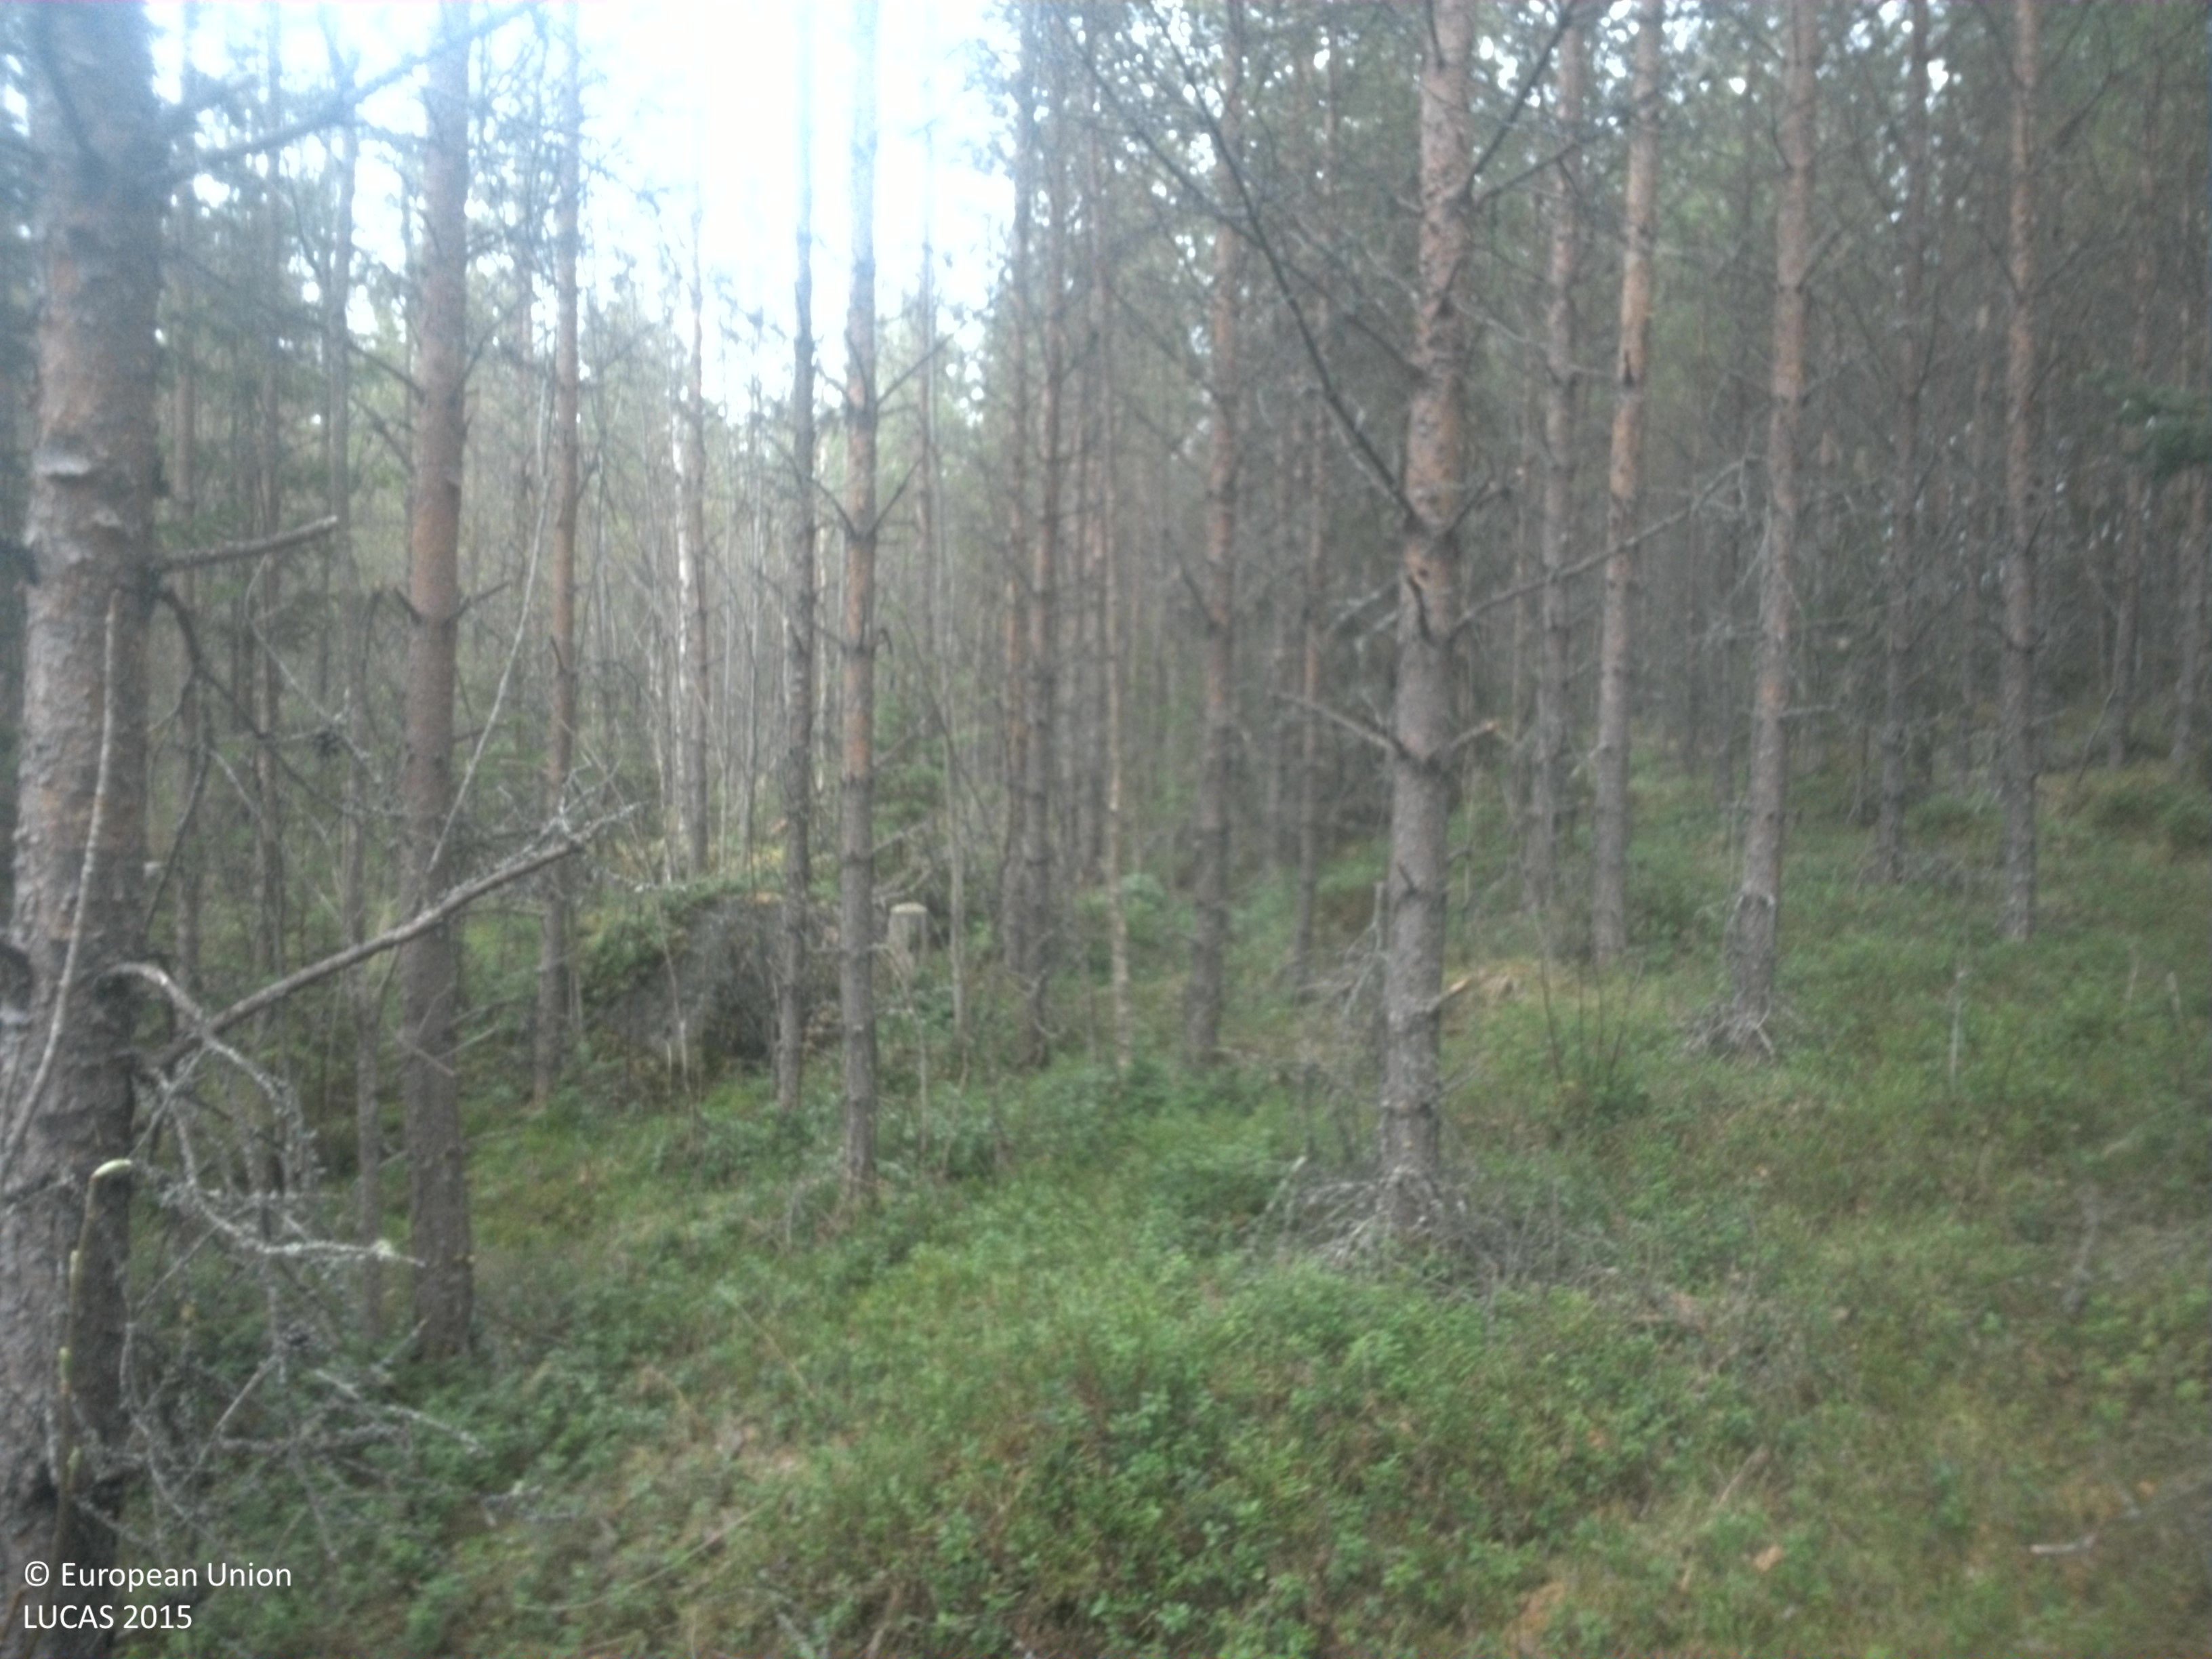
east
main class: Woodland
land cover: Pine dominated mixed woodland
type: boreal forest
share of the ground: 50 - 75 %
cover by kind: coniferous forest trees 45 %, shrubs 30 %, broadleaved forest trees 15 %, herbaceous plants 5 %, lichens and mosses 5 %
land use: Forestry
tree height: > 5 m
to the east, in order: Pine dominated mixed woodland; Pine dominated coniferous woodland; Spruce dominated coniferous woodland; Pine dominated coniferous woodland
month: May
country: SE
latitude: 62.7227
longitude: 15.1623
